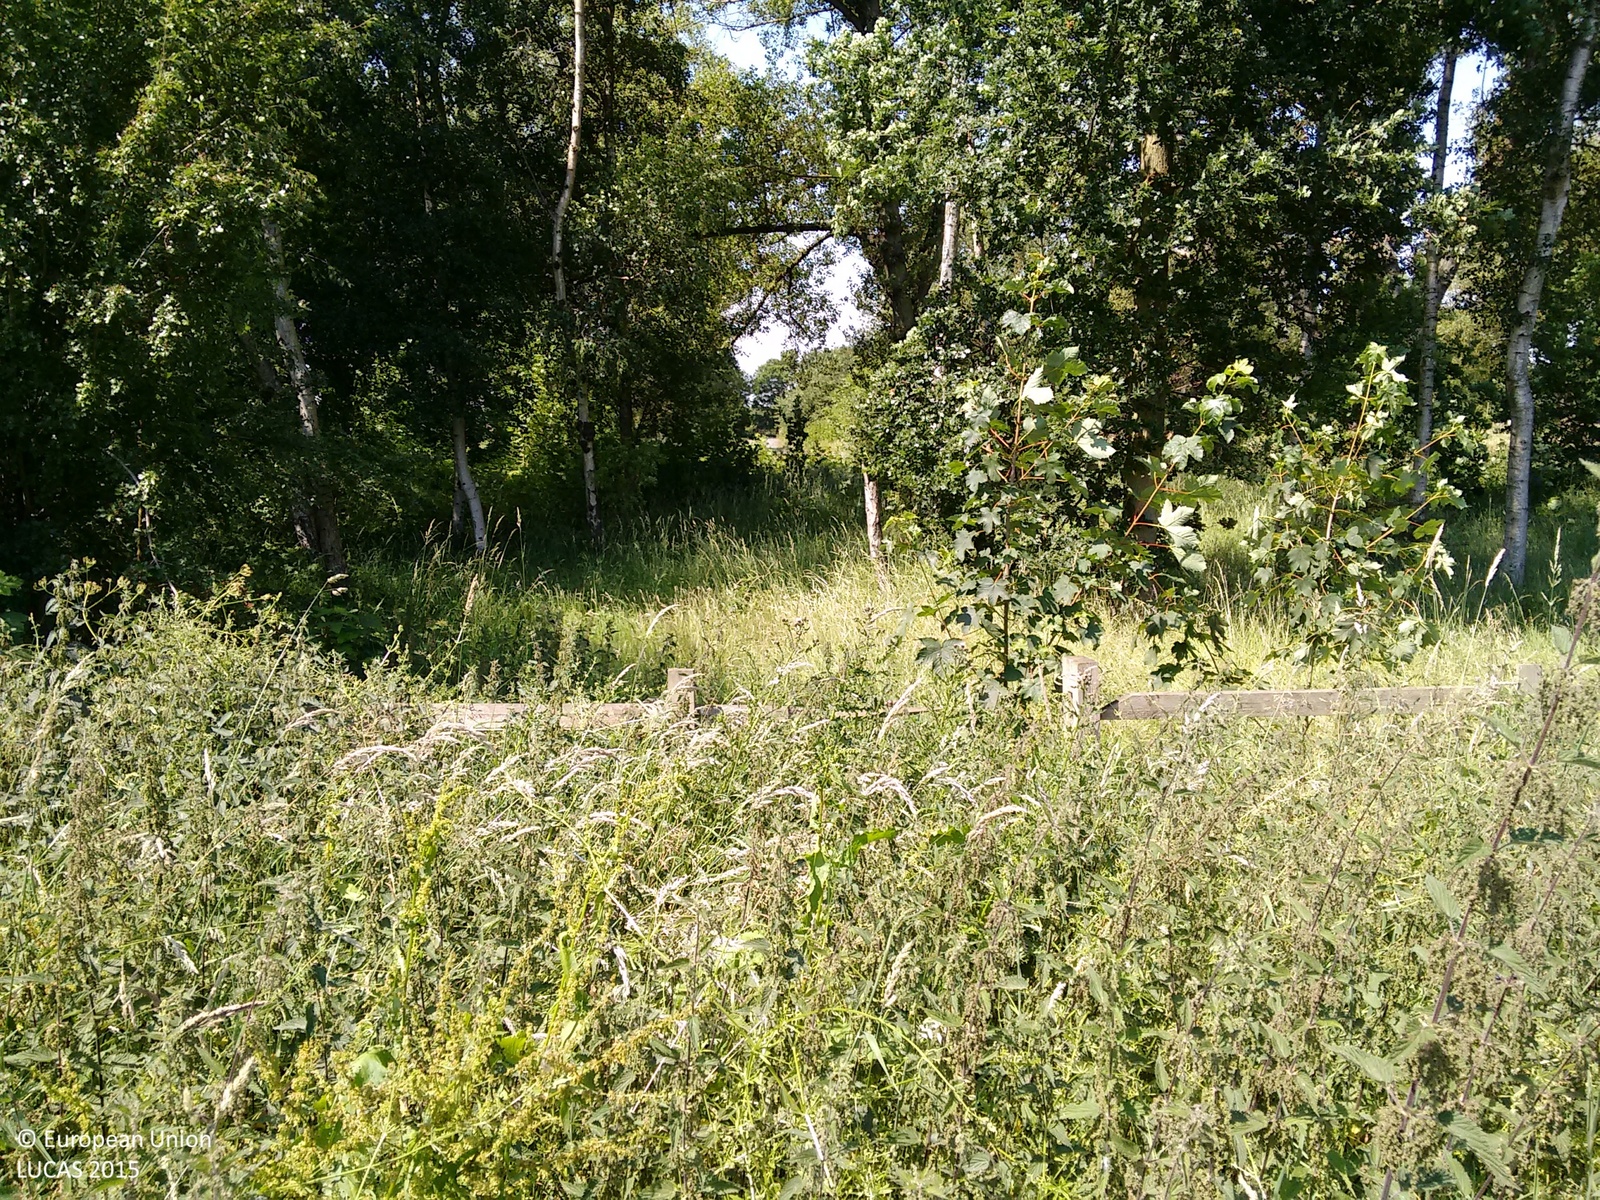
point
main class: Woodland
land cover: Broadleaved woodland
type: mesophytic deciduous forest
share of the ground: > 75 %
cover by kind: broadleaved forest trees 90 %, coniferous forest trees 5 %, shrubs 5 %
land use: Semi-natural and natural areas not in use
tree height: > 5 m
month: July
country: GB
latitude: 53.1468
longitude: -0.6701
